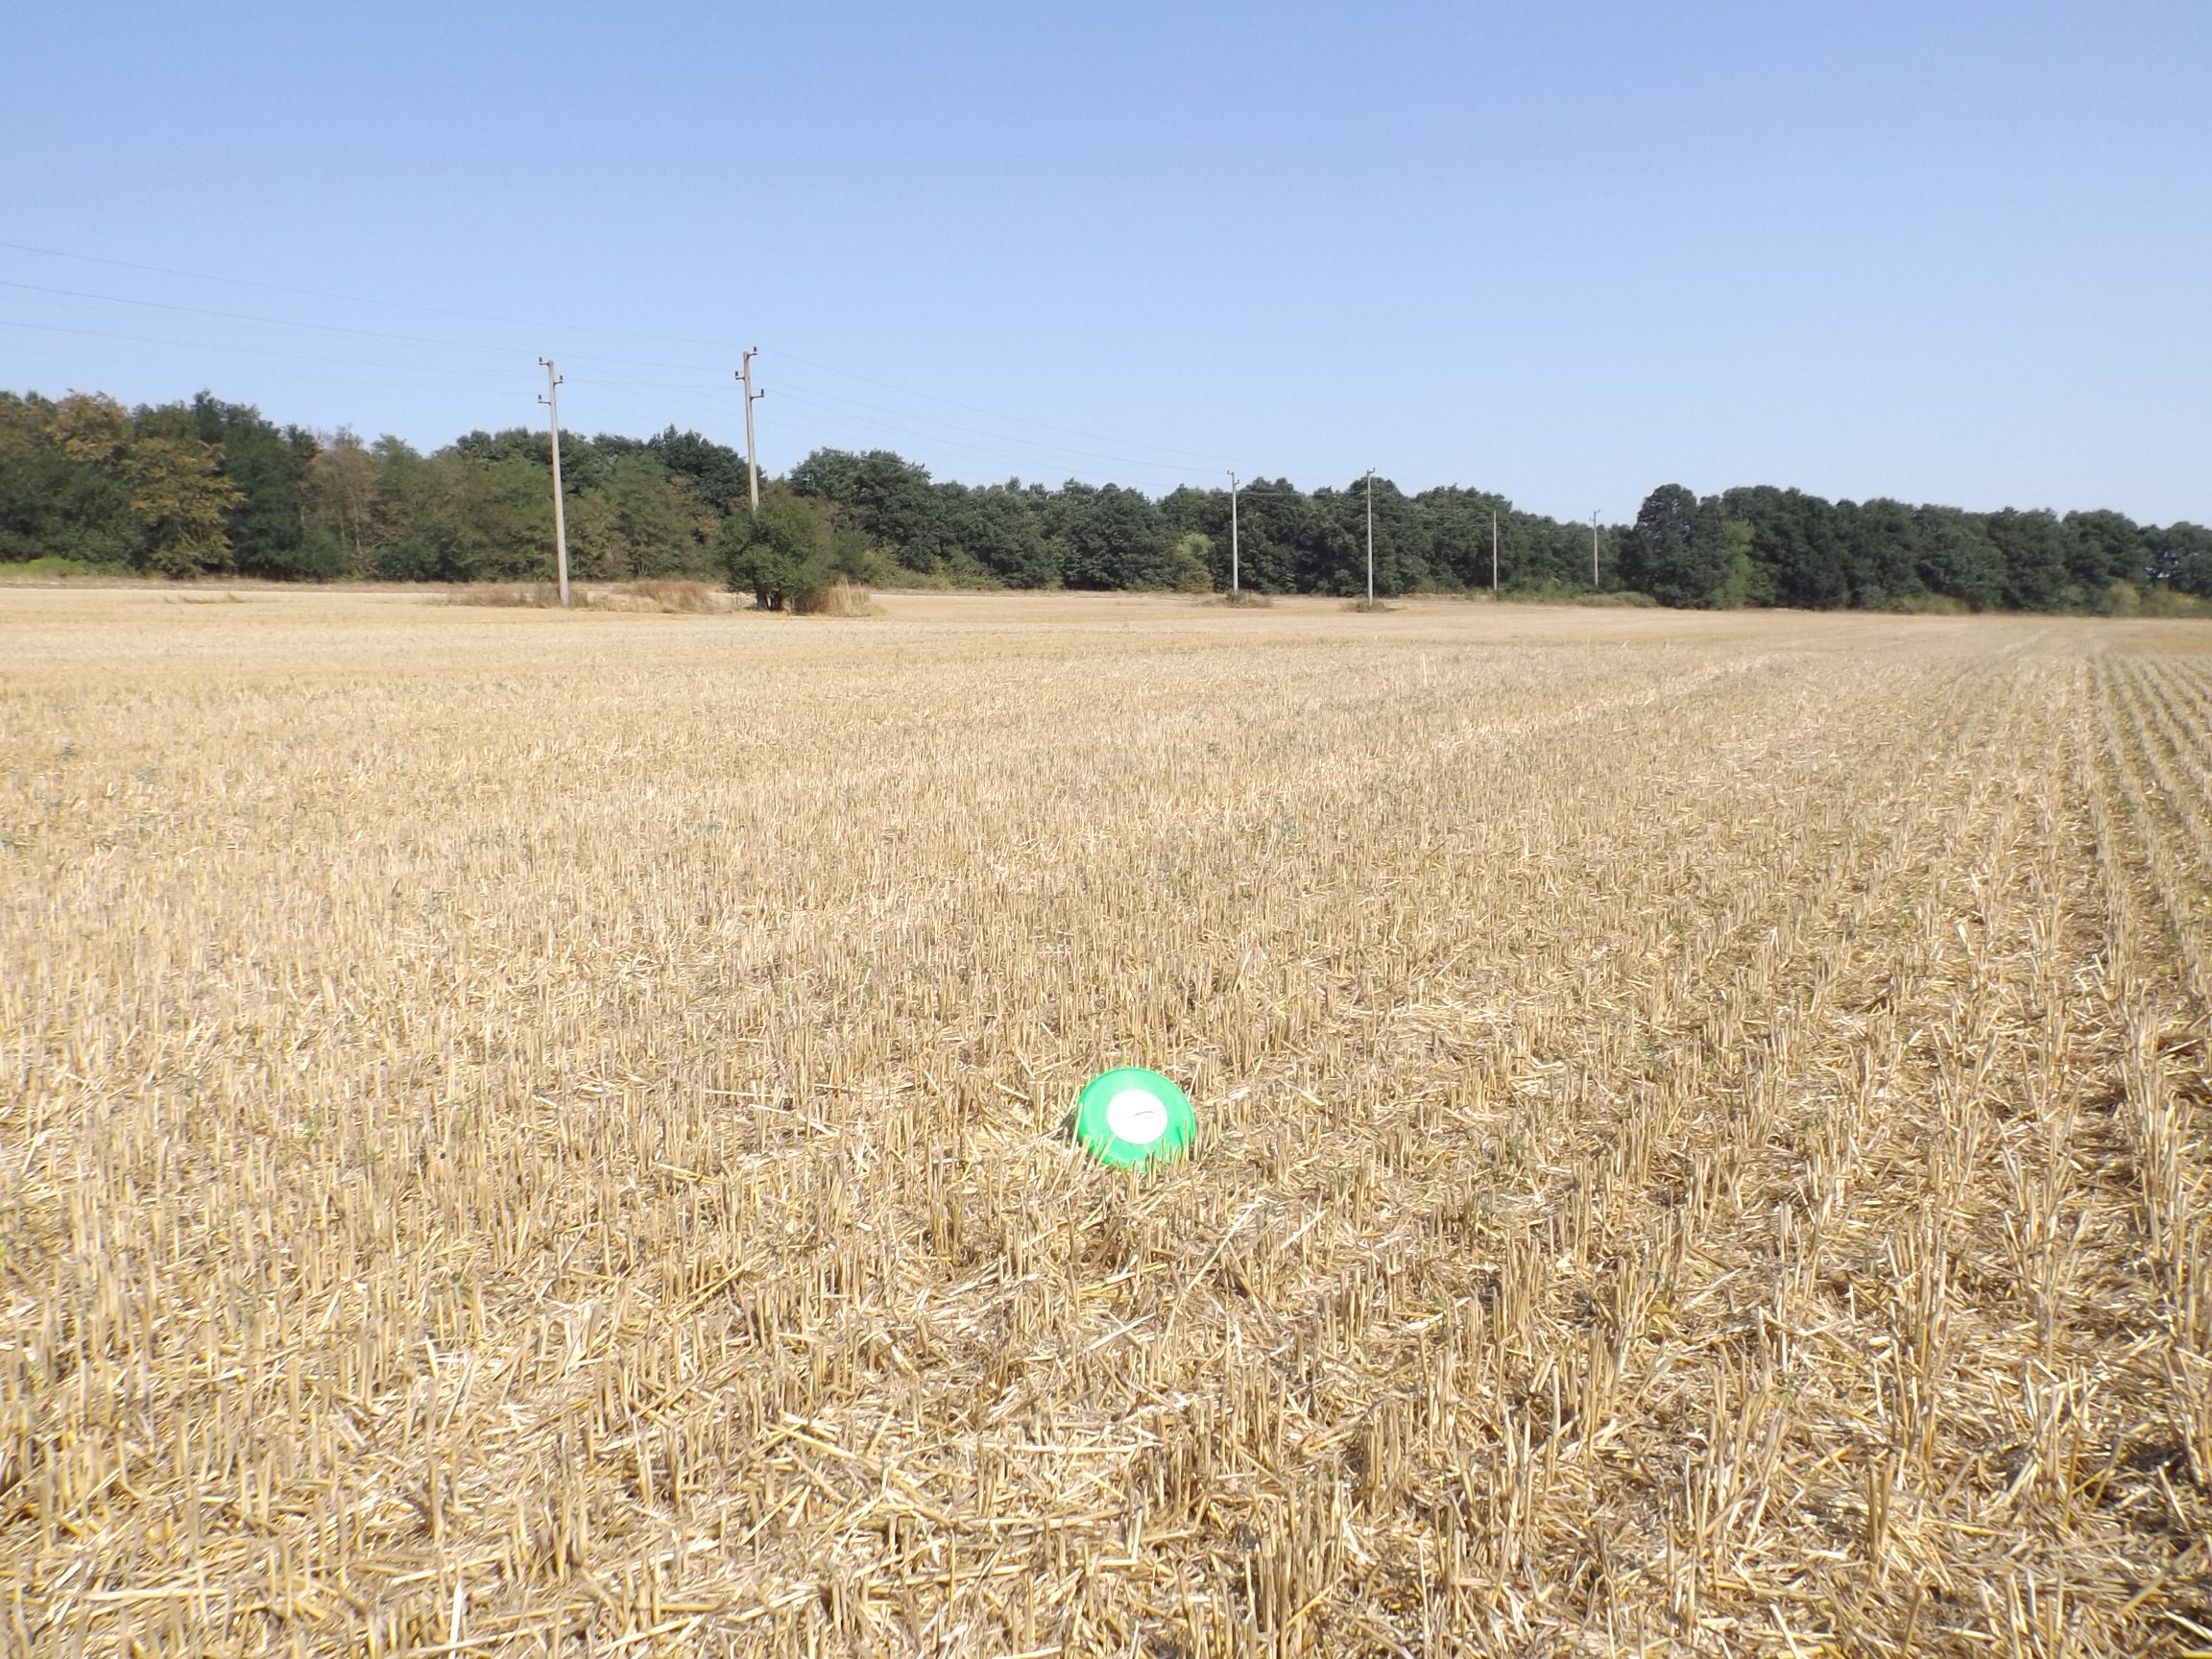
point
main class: Cropland
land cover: Common wheat
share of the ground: 25 - 50 %
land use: Agriculture (excluding fallow land and kitchen gardens)
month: August
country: BG
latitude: 43.4323
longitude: 27.5376
